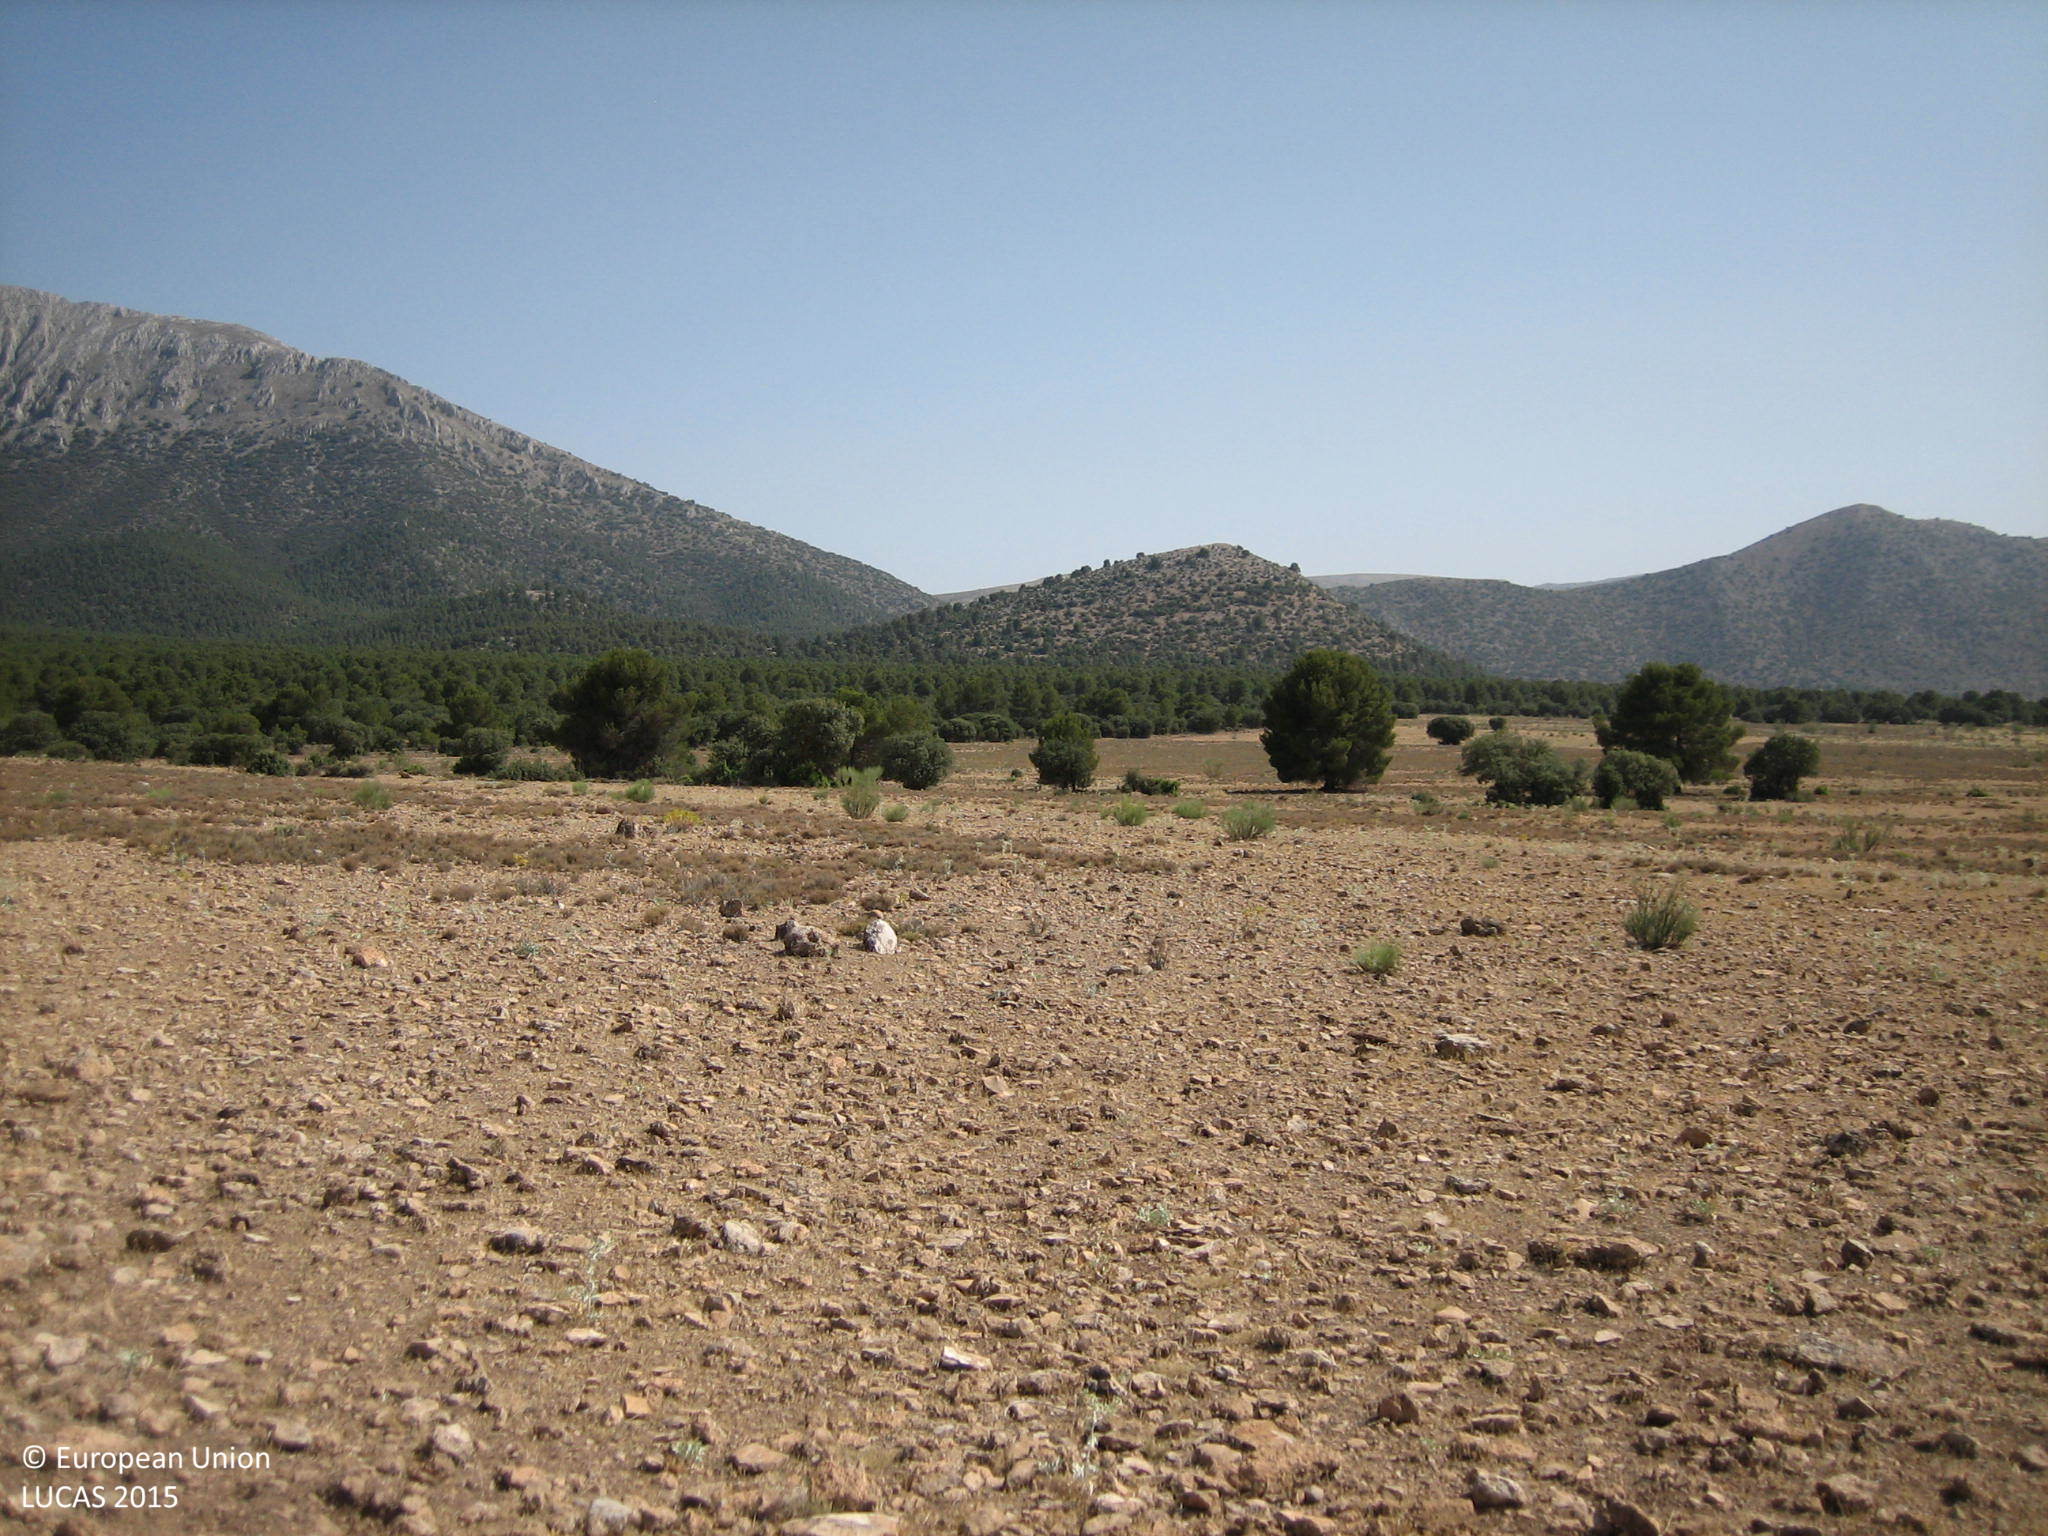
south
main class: Grassland
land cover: Grassland without tree/shrub cover
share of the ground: 10 - 25 %
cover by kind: unconsolidated bare surface 70 %, consolidated bare surface 15 %, herbaceous plants 10 %, shrubs 5 %
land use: Agriculture (excluding fallow land and kitchen gardens)
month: July
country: ES
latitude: 37.7009
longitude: -2.2698
